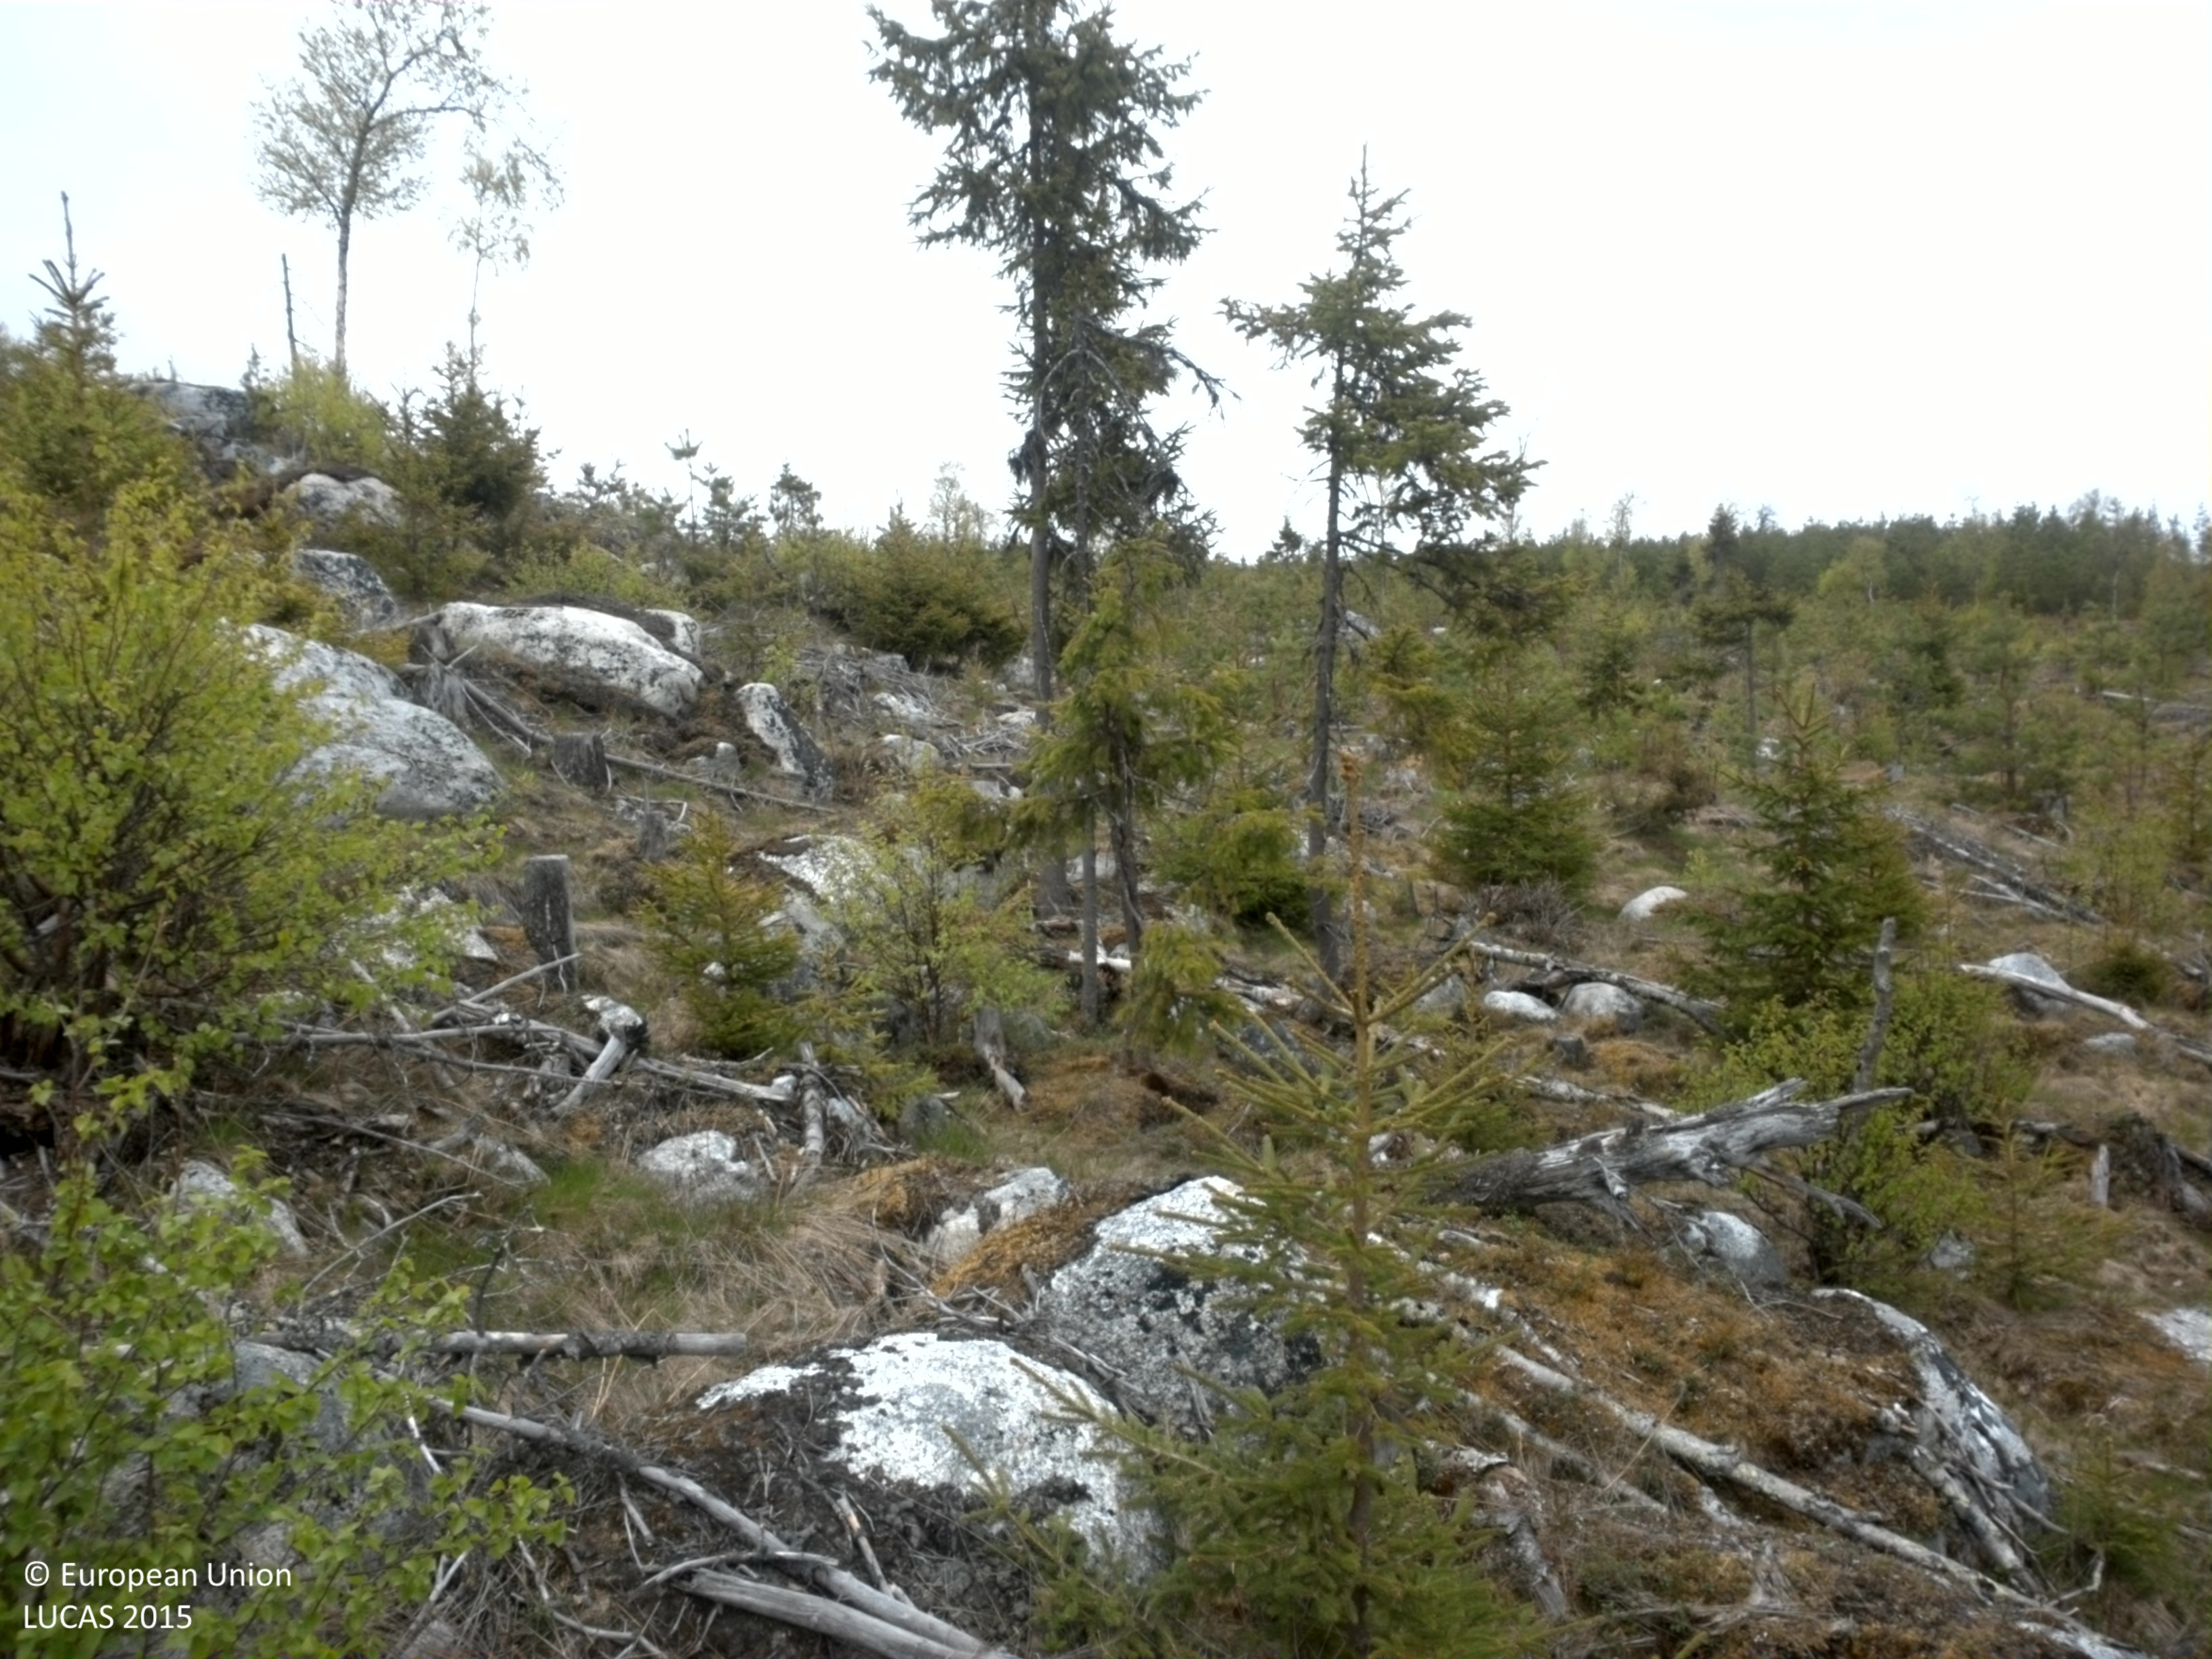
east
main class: Woodland
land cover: Spruce dominated coniferous woodland
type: boreal forest
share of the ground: 25 - 50 %
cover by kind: herbaceous plants 35 %, coniferous forest trees 30 %, unconsolidated bare surface 20 %, broadleaved forest trees 5 %, shrubs 5 %, lichens and mosses 5 %
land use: Forestry
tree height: < 5 m
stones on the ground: 25 - 50 %
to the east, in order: Spruce dominated coniferous woodland; Pine dominated coniferous woodland
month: June
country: SE
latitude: 64.3146
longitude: 17.4334
